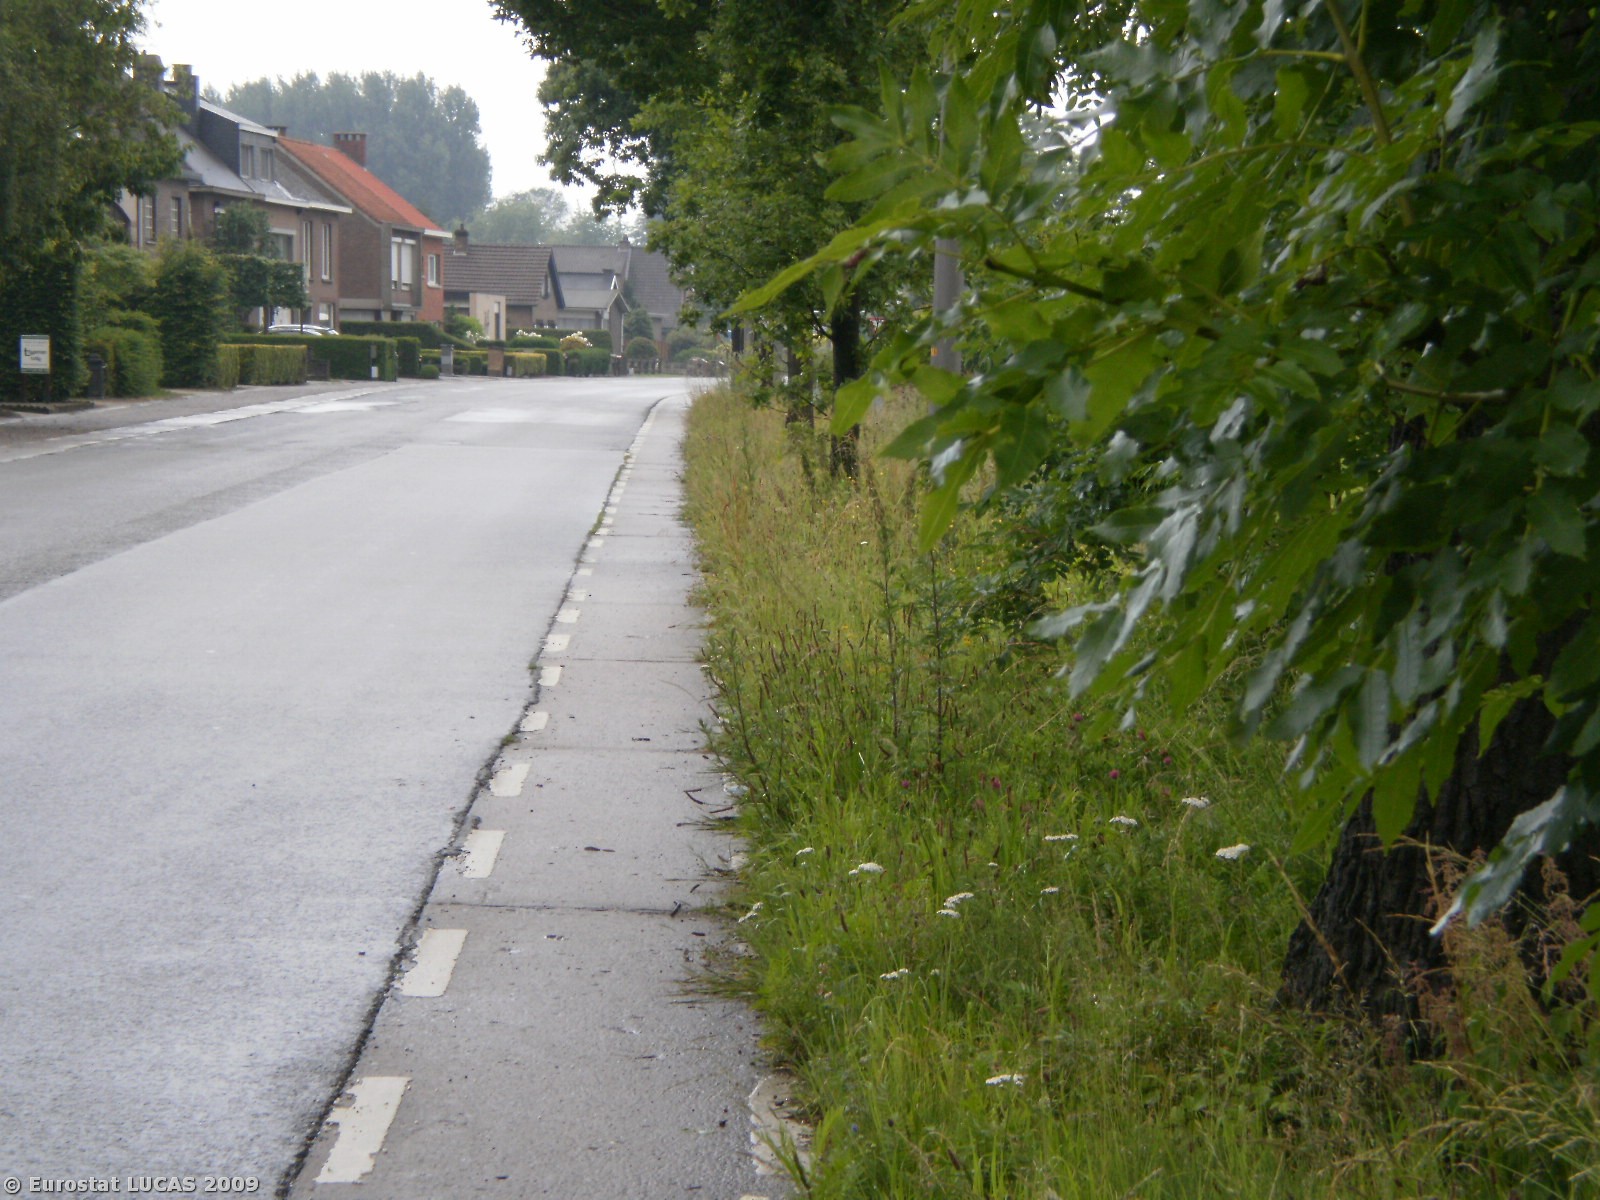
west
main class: Grassland
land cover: Grassland without tree/shrub cover
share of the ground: > 75 %
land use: Agriculture (excluding fallow land and kitchen gardens)
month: June
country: BE
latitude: 51.1337
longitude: 4.1496
